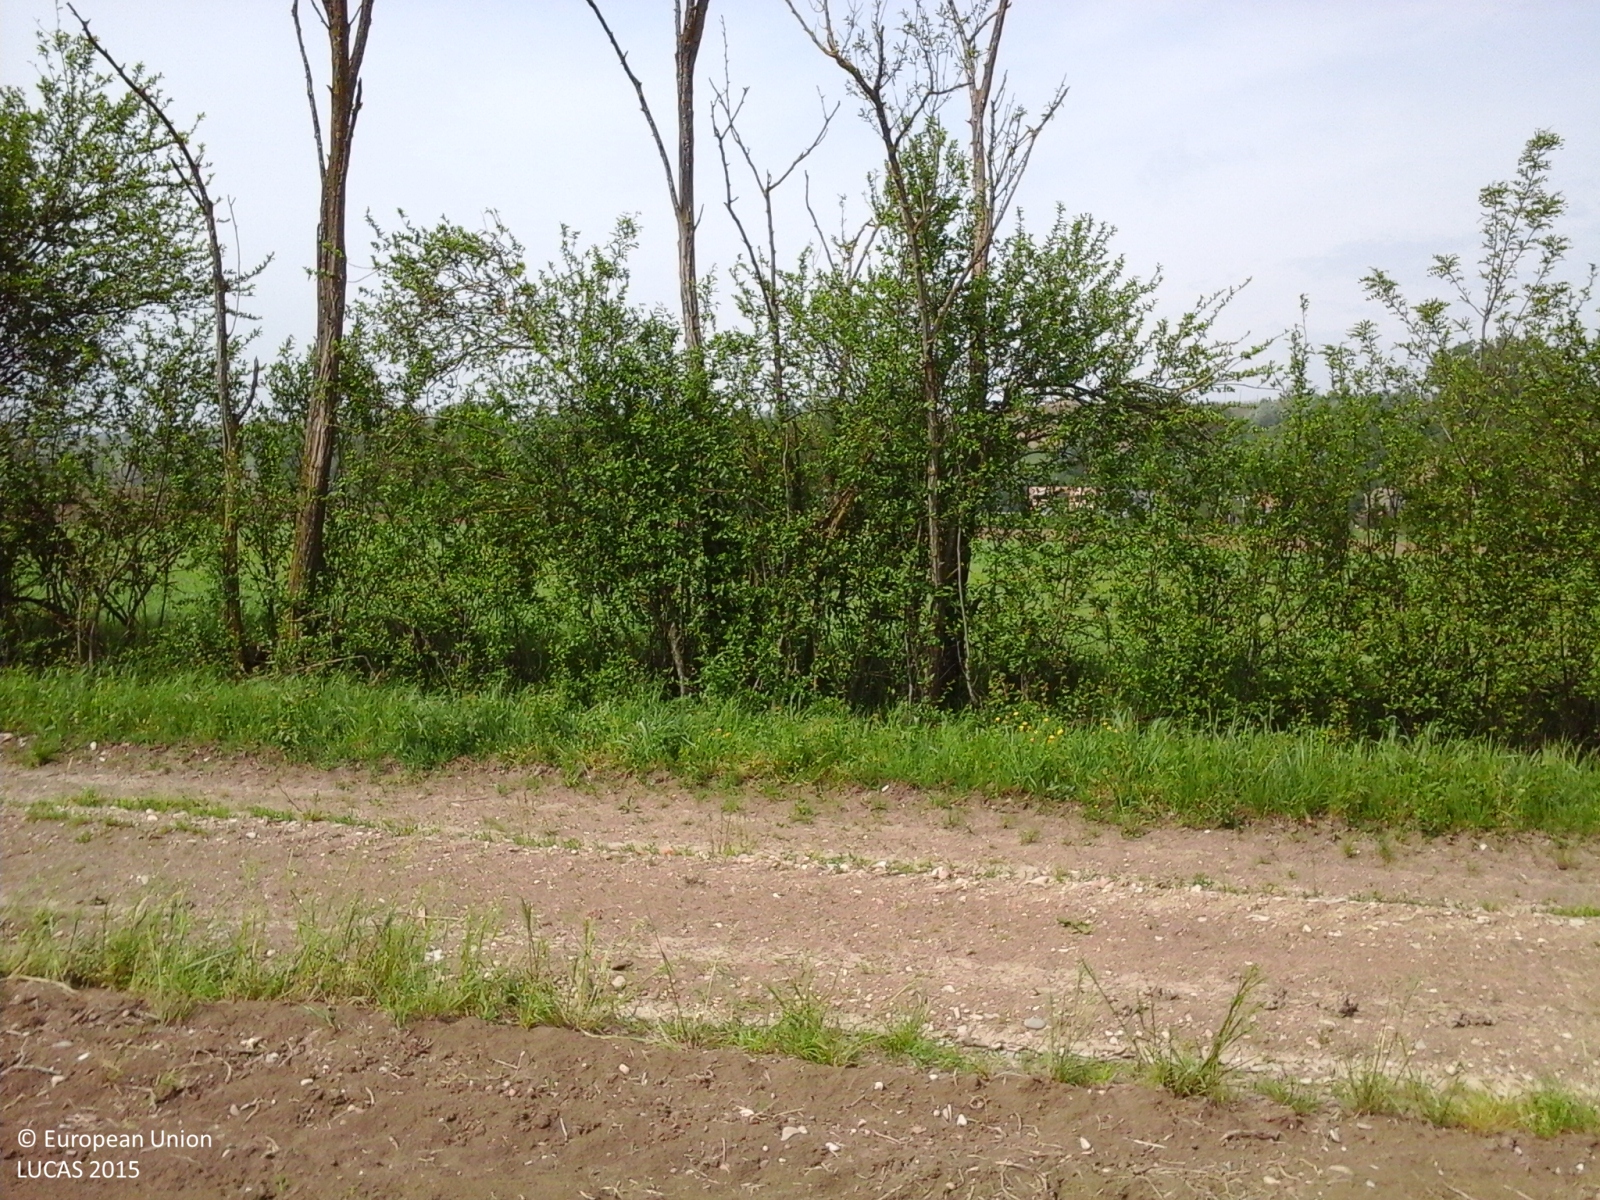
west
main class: Cropland
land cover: Maize
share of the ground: < 10 %
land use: Agriculture (excluding fallow land and kitchen gardens)
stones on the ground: < 10 %
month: April
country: IT
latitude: 45.0519
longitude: 9.3790
